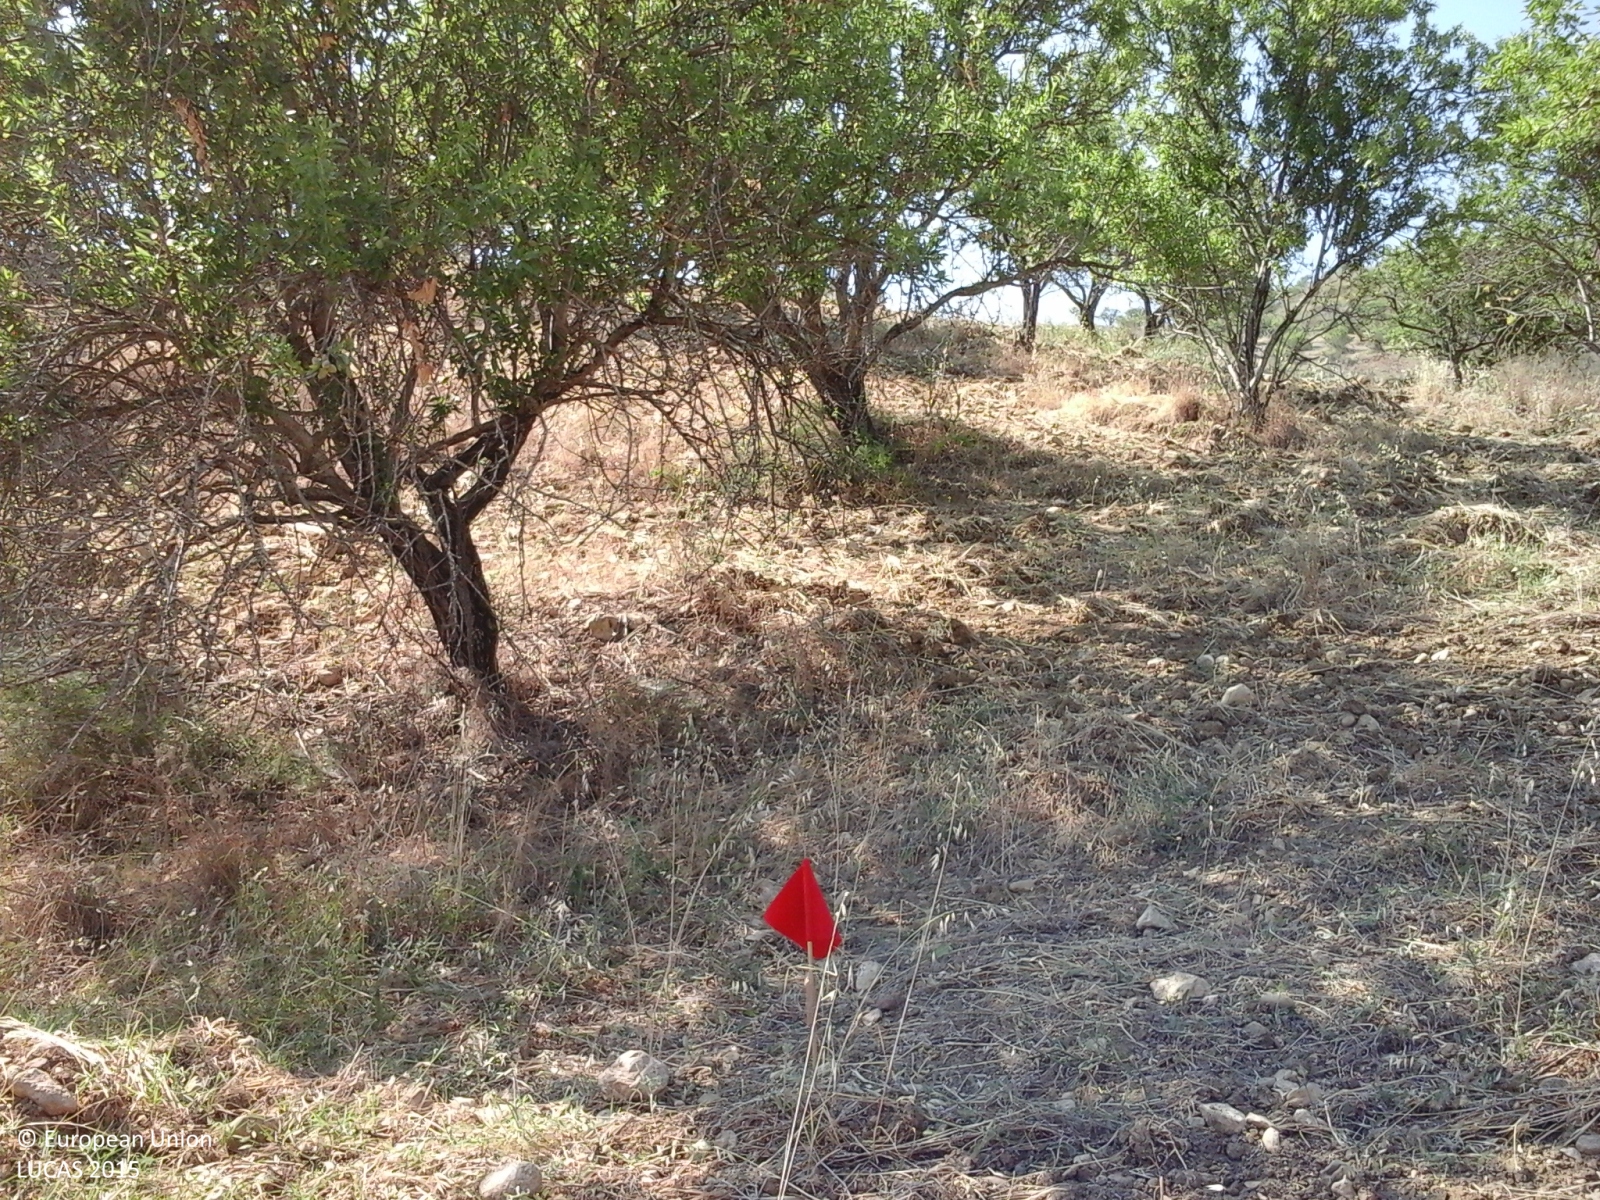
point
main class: Cropland
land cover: Nuts trees
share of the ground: 25 - 50 %
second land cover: Spontaneously vegetated surfaces
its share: > 75 %
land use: Agriculture (excluding fallow land and kitchen gardens)
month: July
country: IT
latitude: 37.4473
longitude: 13.4886
